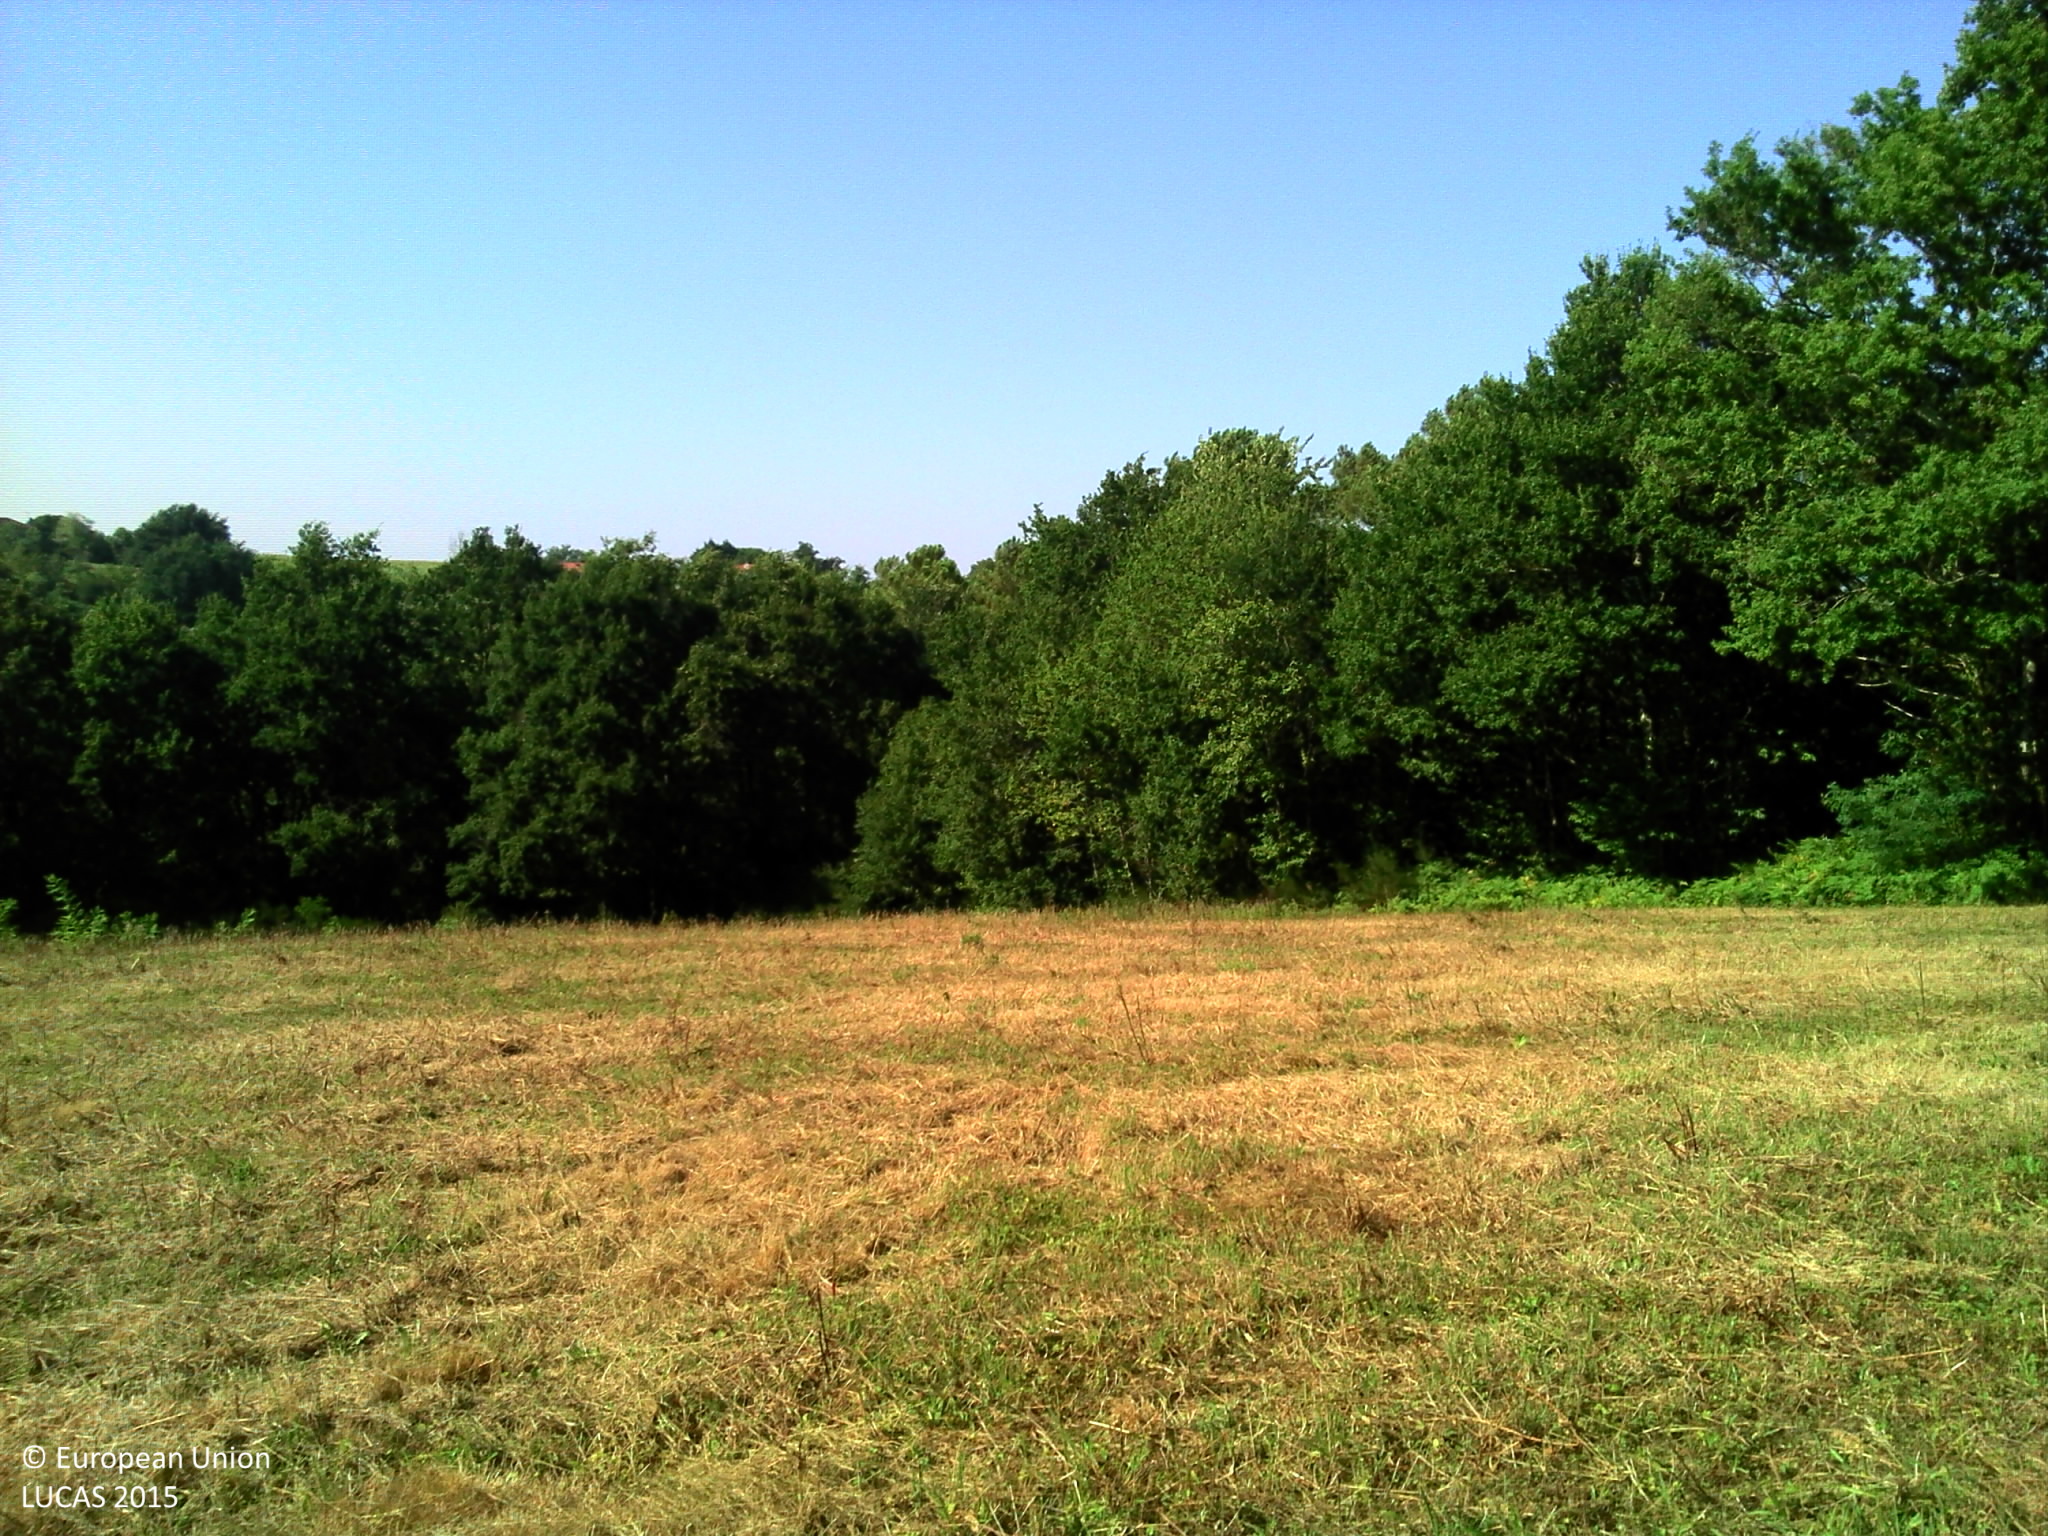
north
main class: Grassland
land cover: Grassland without tree/shrub cover
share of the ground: > 75 %
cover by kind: herbaceous plants 95 %, lichens and mosses 5 %
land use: Forestry
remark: Clear cut
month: August
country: FR
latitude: 43.7356
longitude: -0.7528
